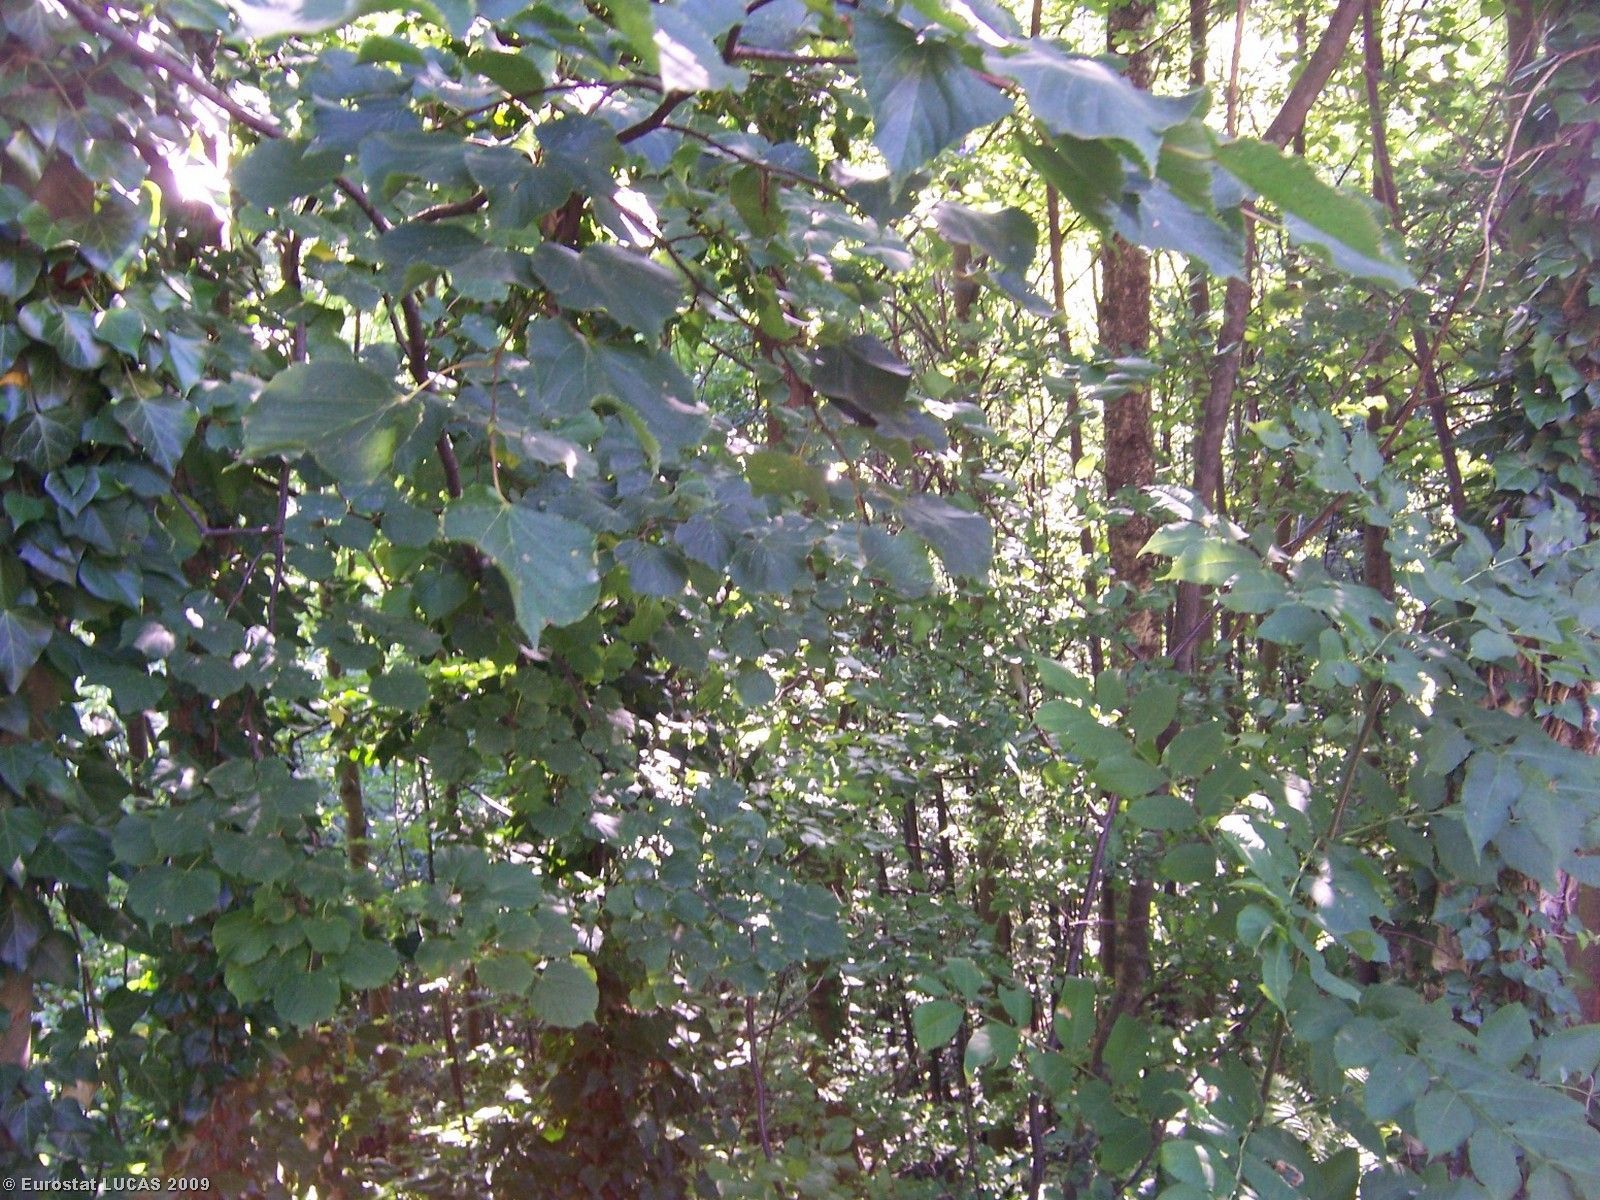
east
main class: Woodland
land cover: Broadleaved woodland
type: mesophytic deciduous forest
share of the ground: > 75 %
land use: Unused
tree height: > 5 m
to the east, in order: Broadleaved woodland; Inland running water; Broadleaved woodland; Electric lines; Broadleaved woodland; Electric lines; Paved roads, cycling and walking lanes; Dry stone walls; Broadleaved woodland; Artificial constructions in urban areas; Railways; Broadleaved woodland; Managed hedges; Tracks; Broadleaved woodland; Spontaneously vegetated surfaces
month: July
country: IT
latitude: 45.3099
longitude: 7.3894
